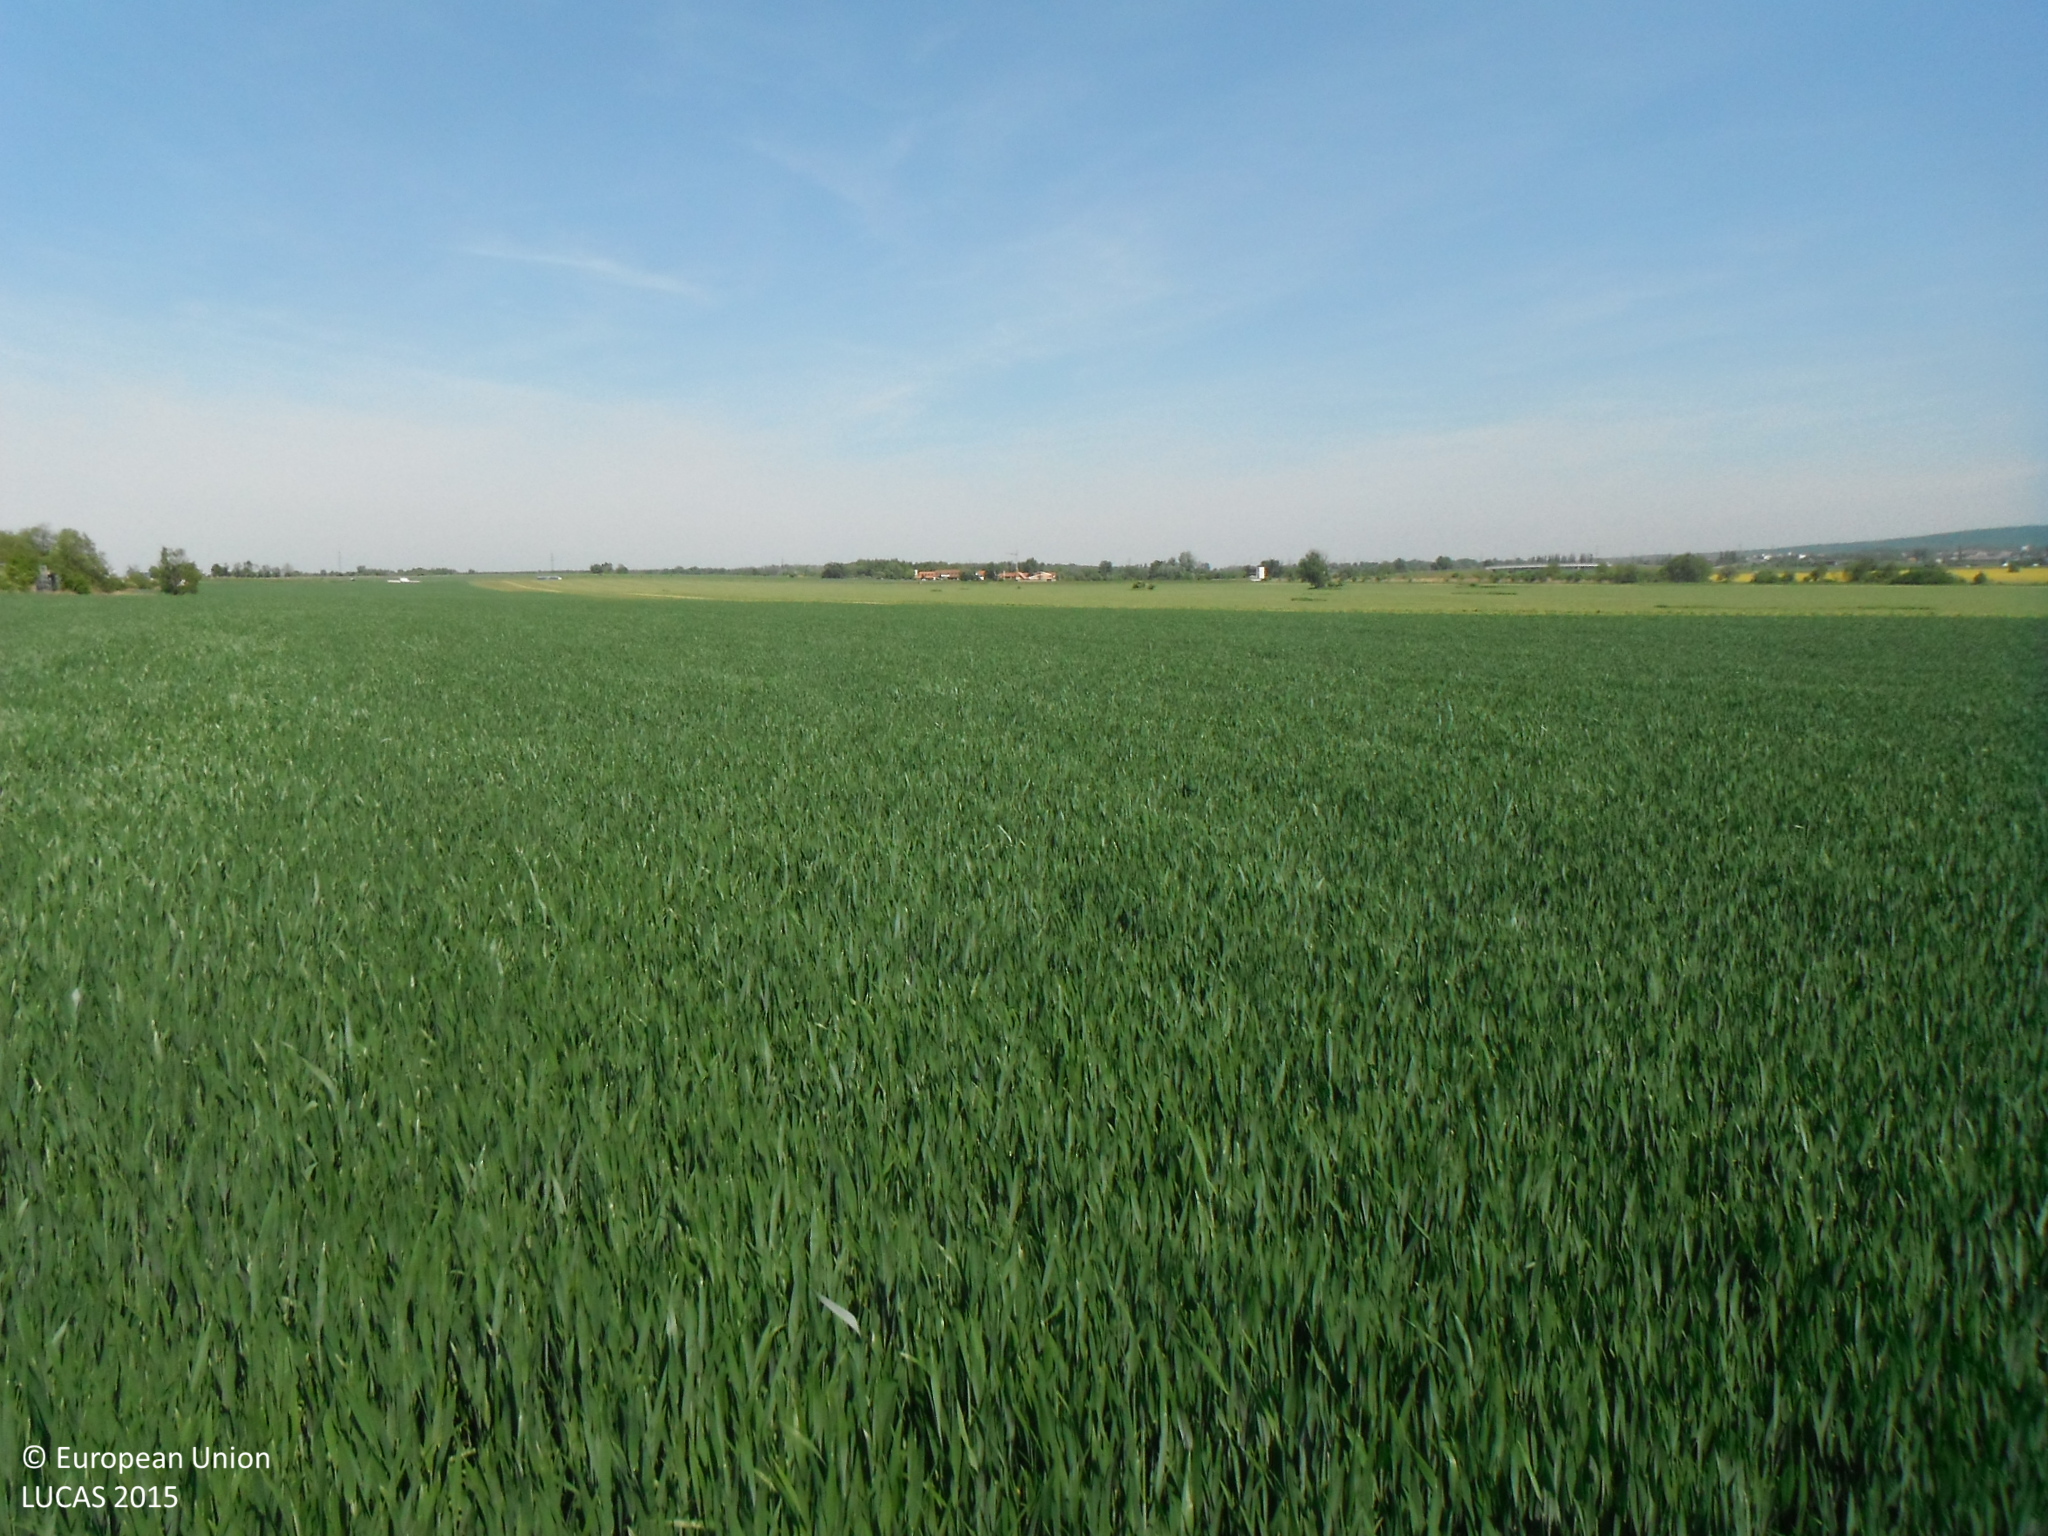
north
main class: Cropland
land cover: Common wheat
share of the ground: > 75 %
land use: Agriculture (excluding fallow land and kitchen gardens)
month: May
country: SK
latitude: 48.2360
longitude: 16.9954
